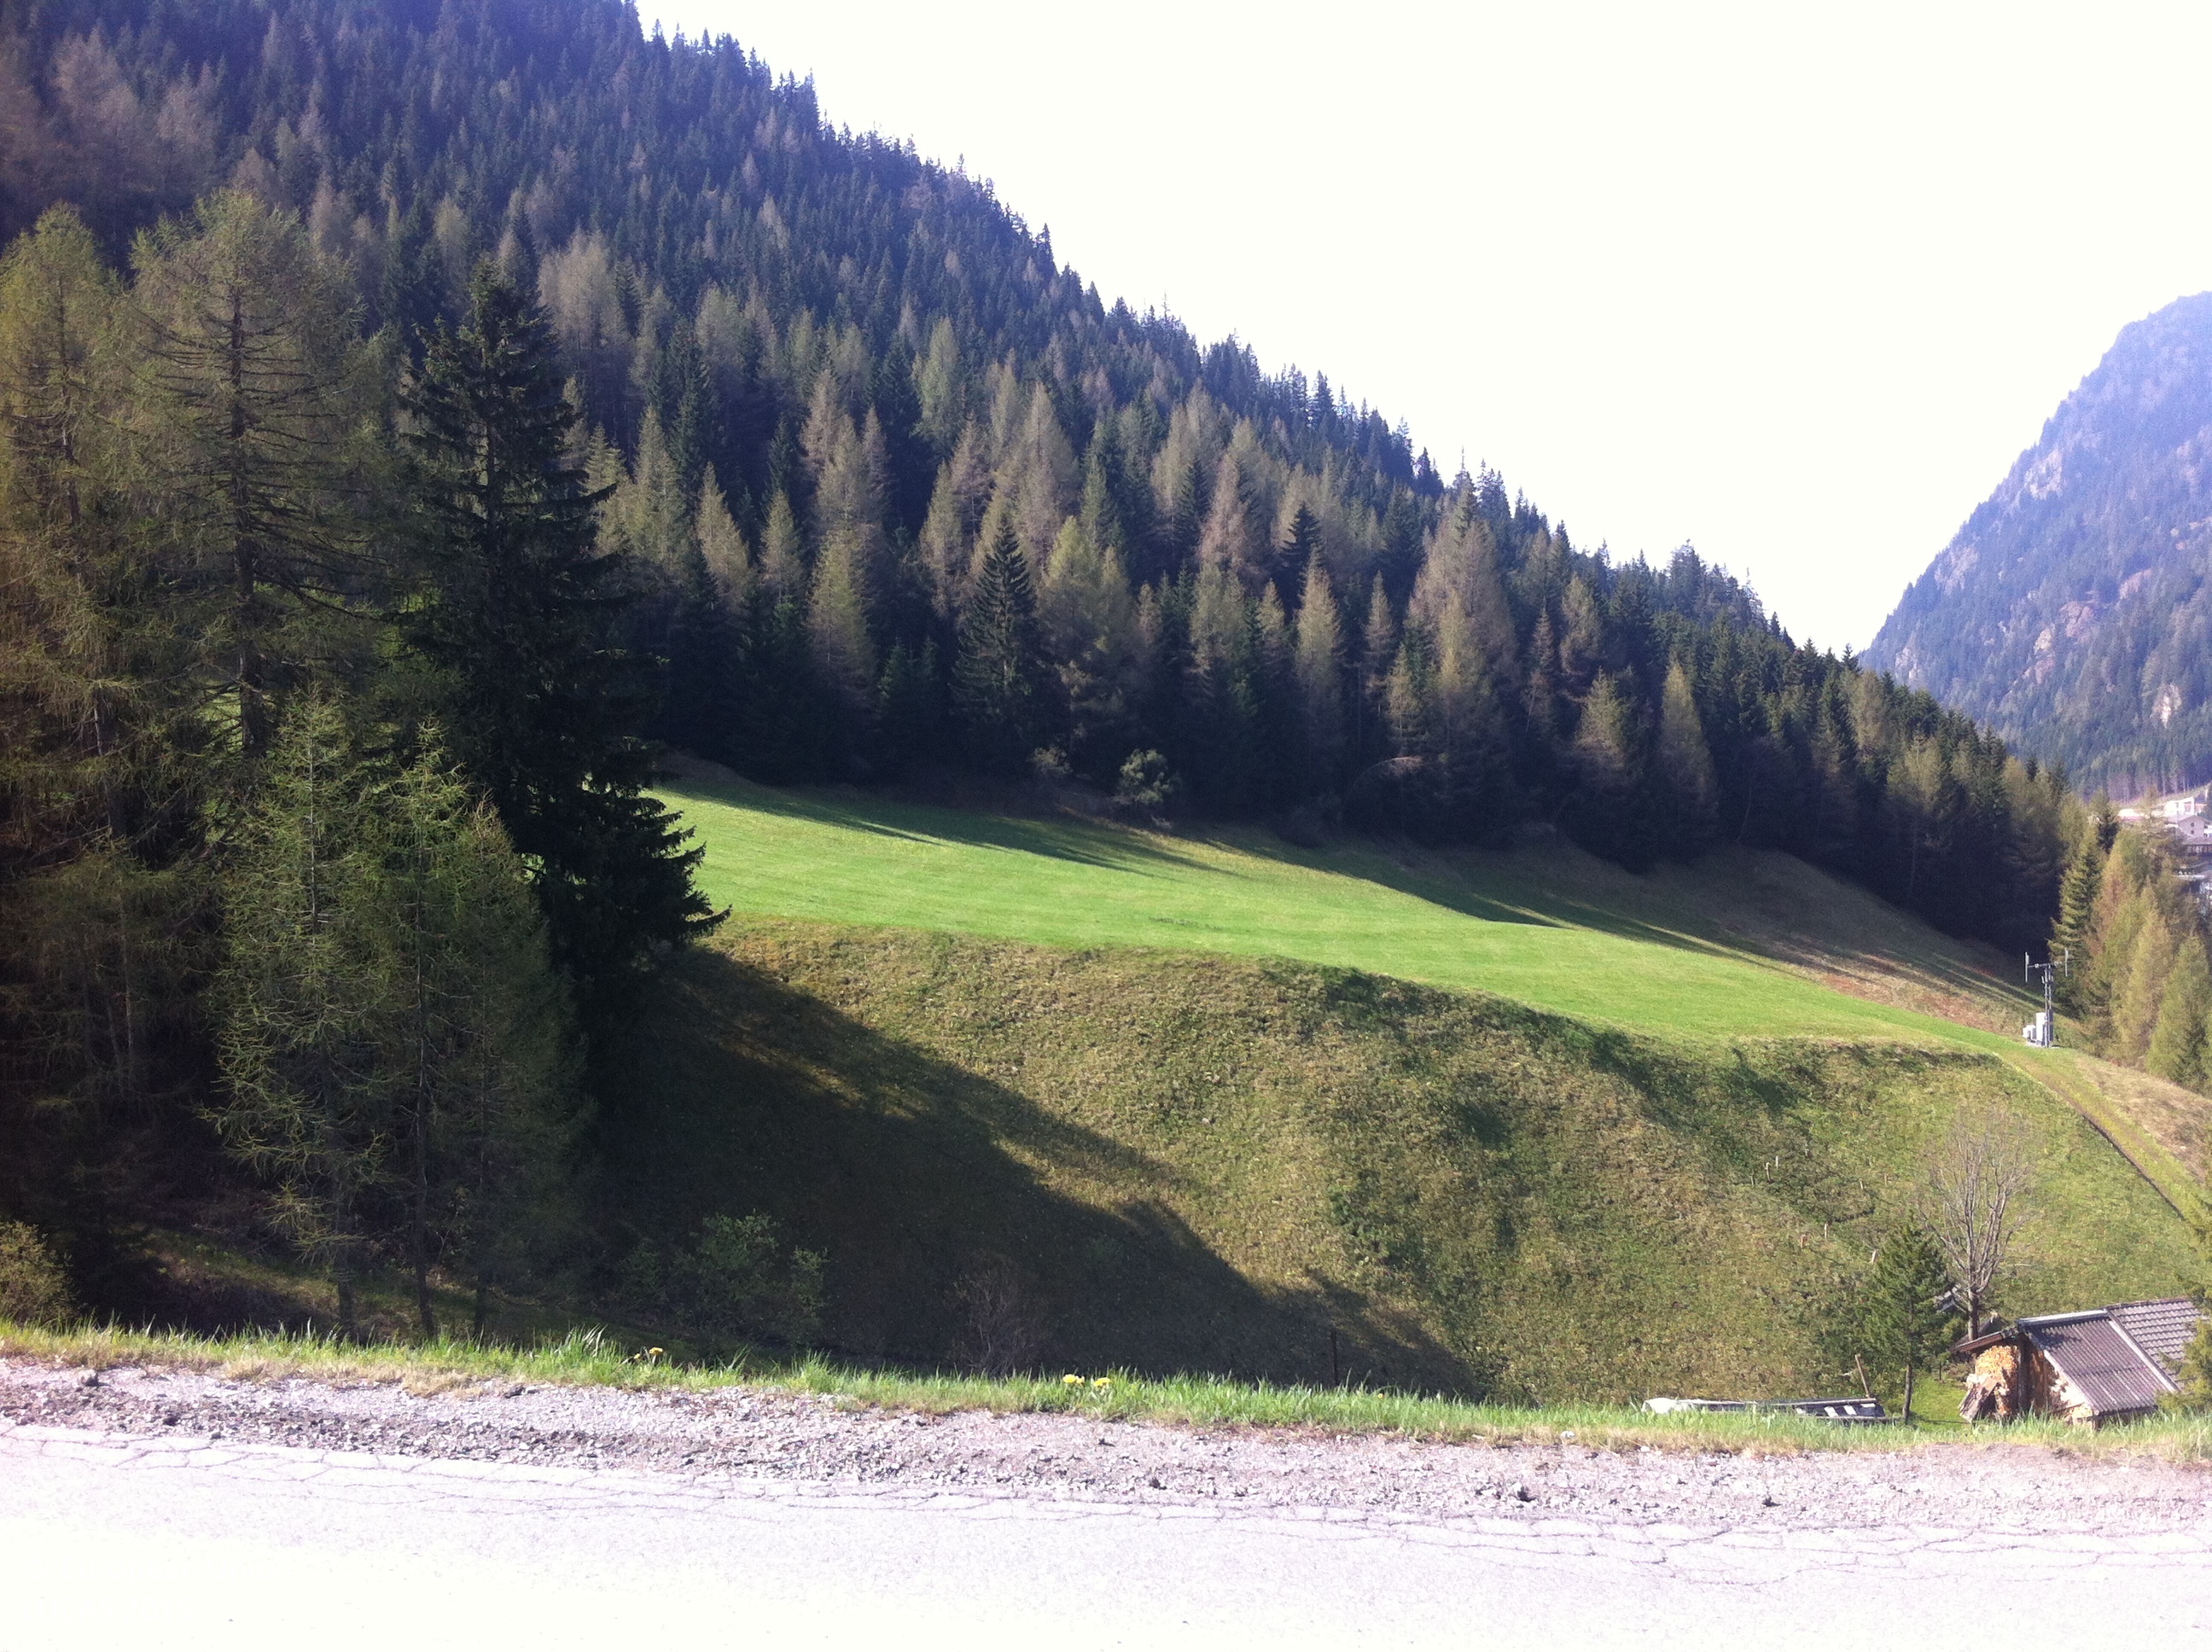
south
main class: Grassland
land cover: Grassland without tree/shrub cover
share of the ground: > 75 %
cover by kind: herbaceous plants 100 %
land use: Agriculture (excluding fallow land and kitchen gardens)
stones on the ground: < 10 %
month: May
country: AT
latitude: 47.0070
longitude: 11.5111
